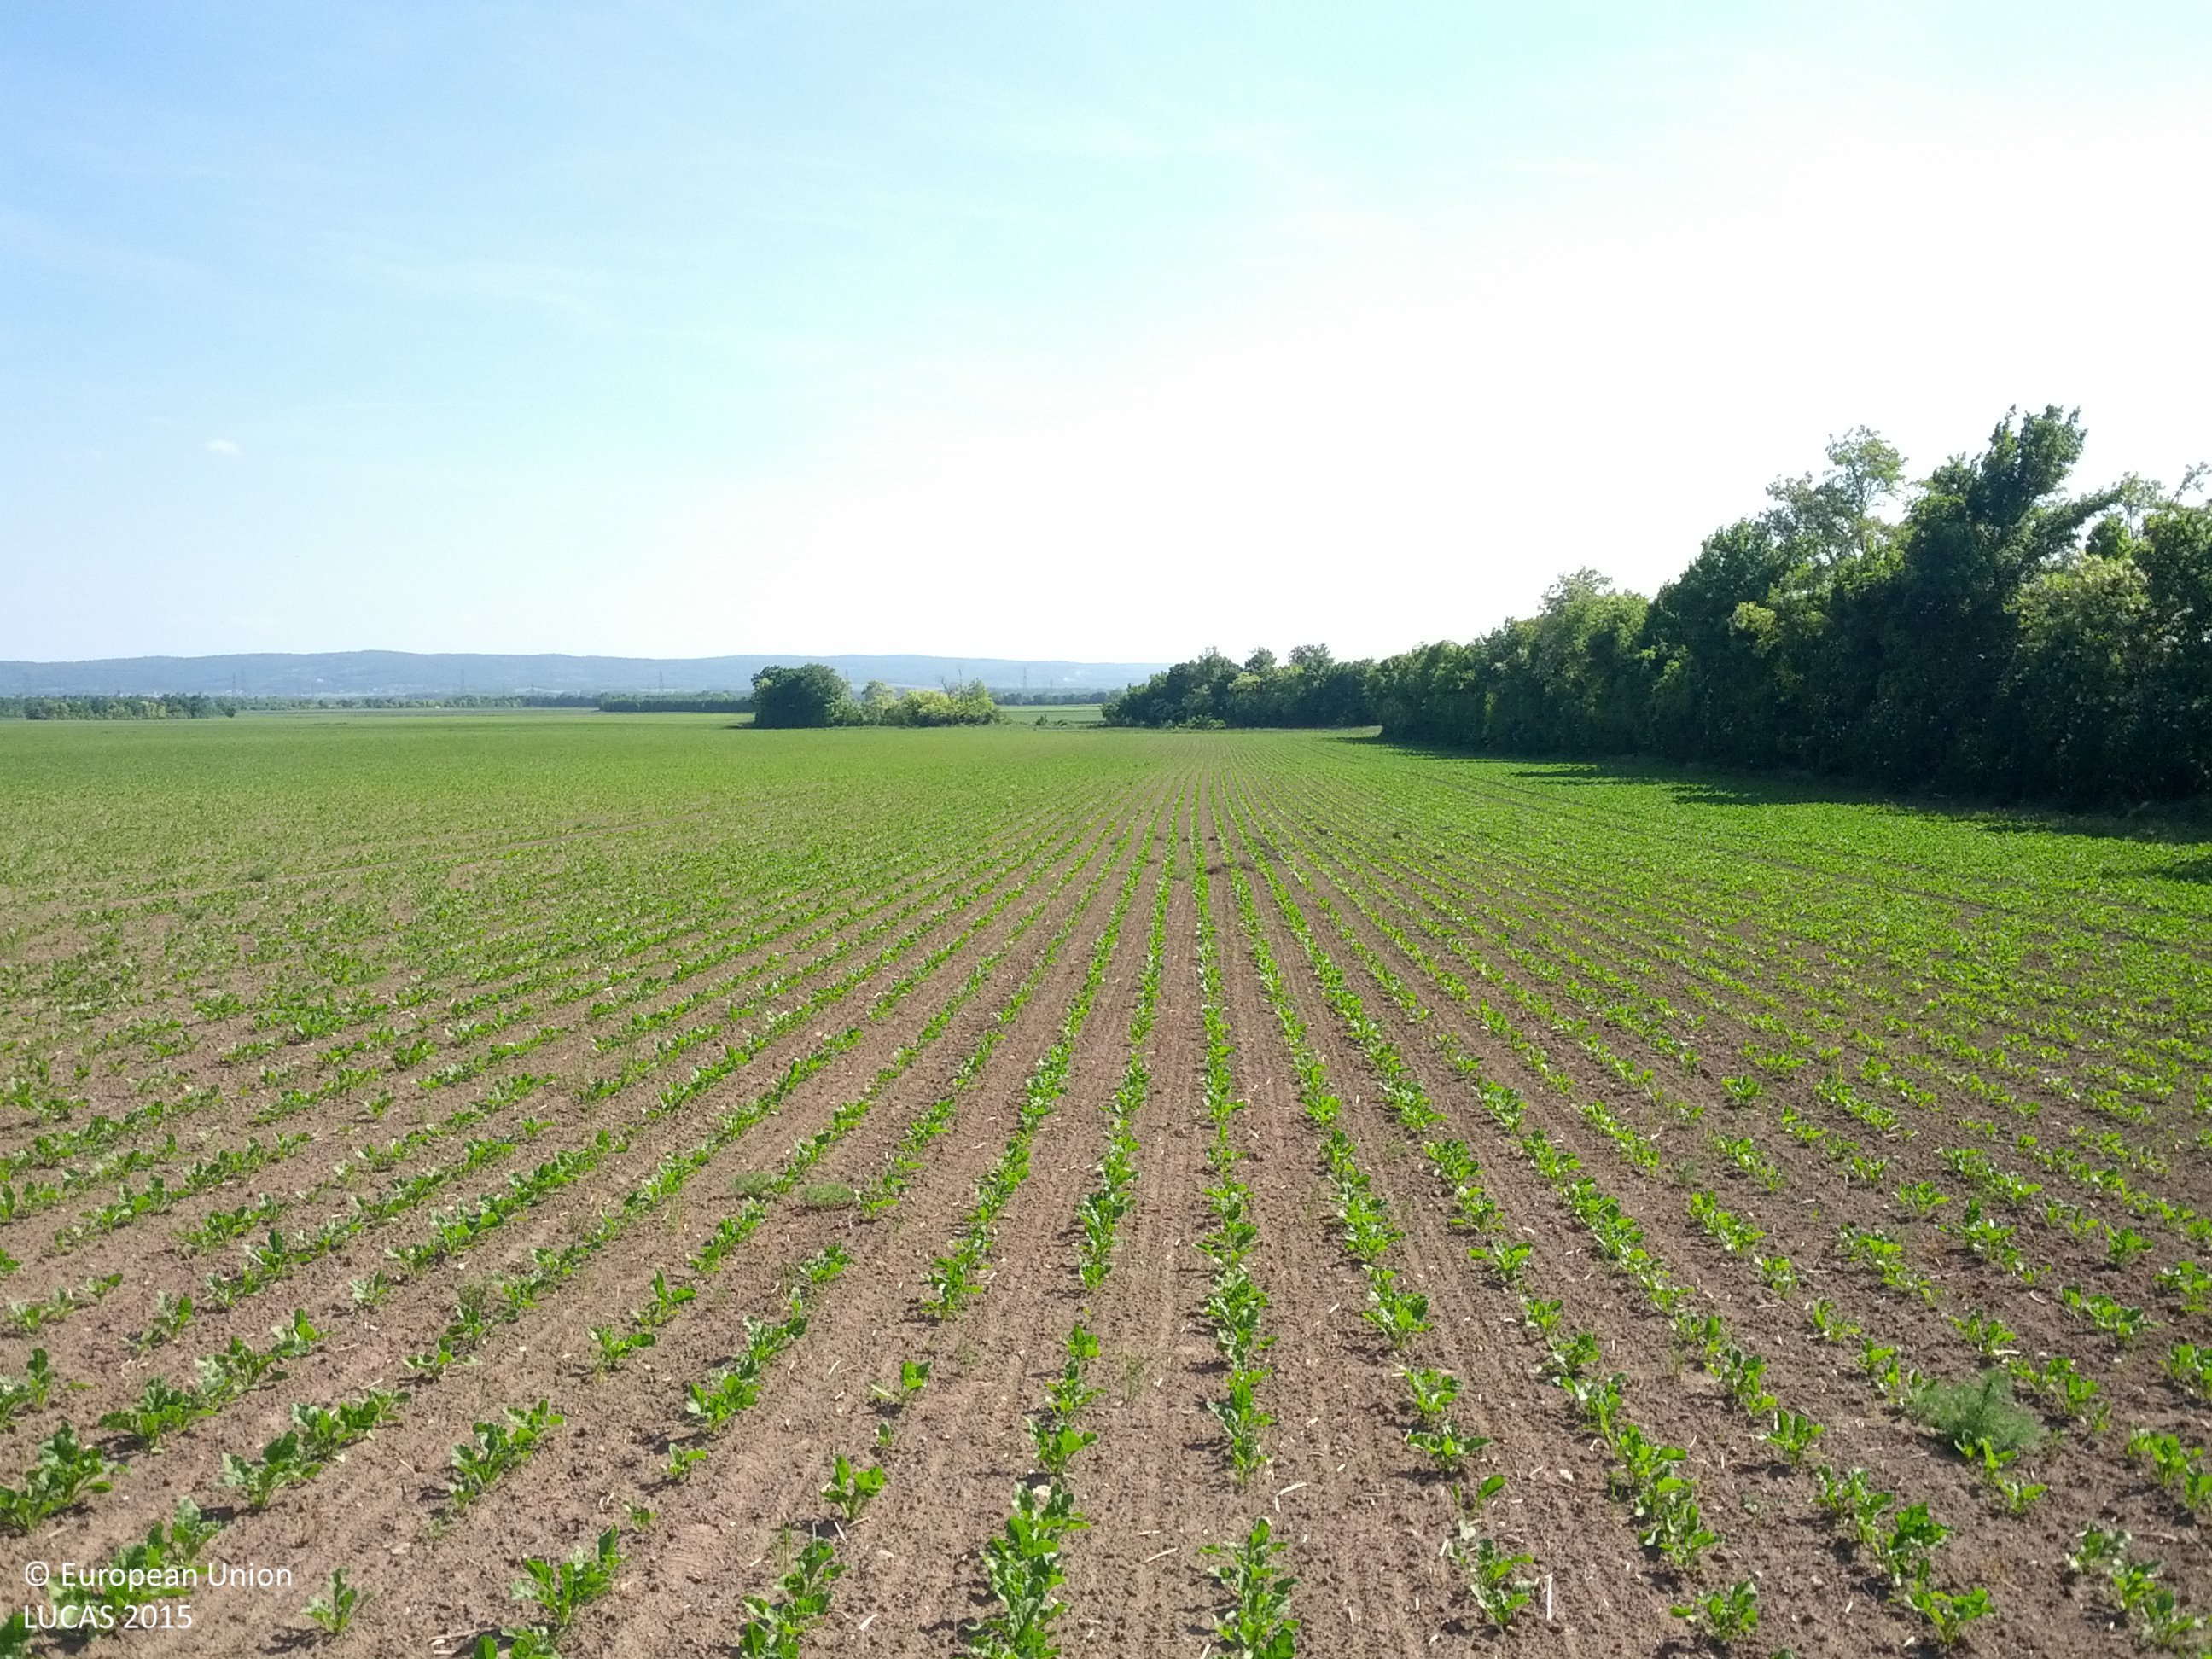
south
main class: Cropland
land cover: Sugar beet
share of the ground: < 10 %
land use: Agriculture (excluding fallow land and kitchen gardens)
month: May
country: AT
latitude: 48.0606
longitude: 16.6208
